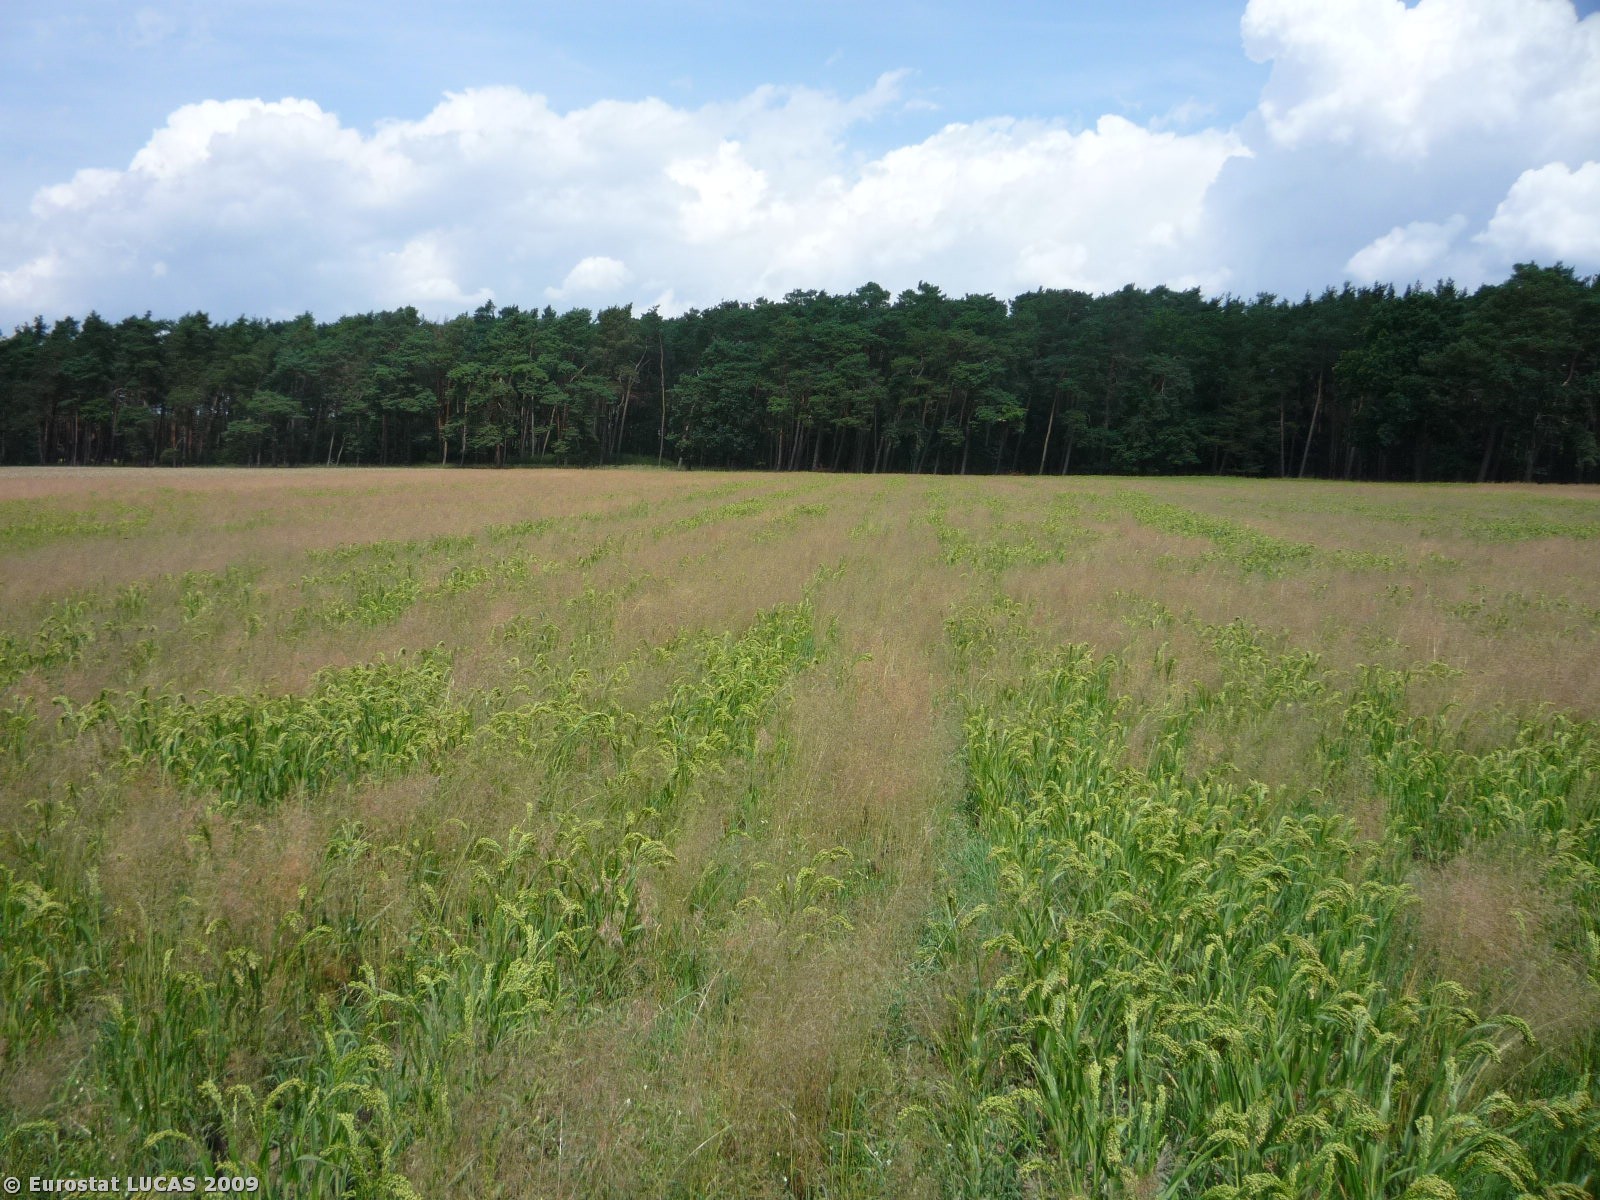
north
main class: Cropland
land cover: Other cereals
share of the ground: > 75 %
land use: Agriculture (excluding fallow land and kitchen gardens)
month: July
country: CZ
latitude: 50.1455
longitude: 15.0265
